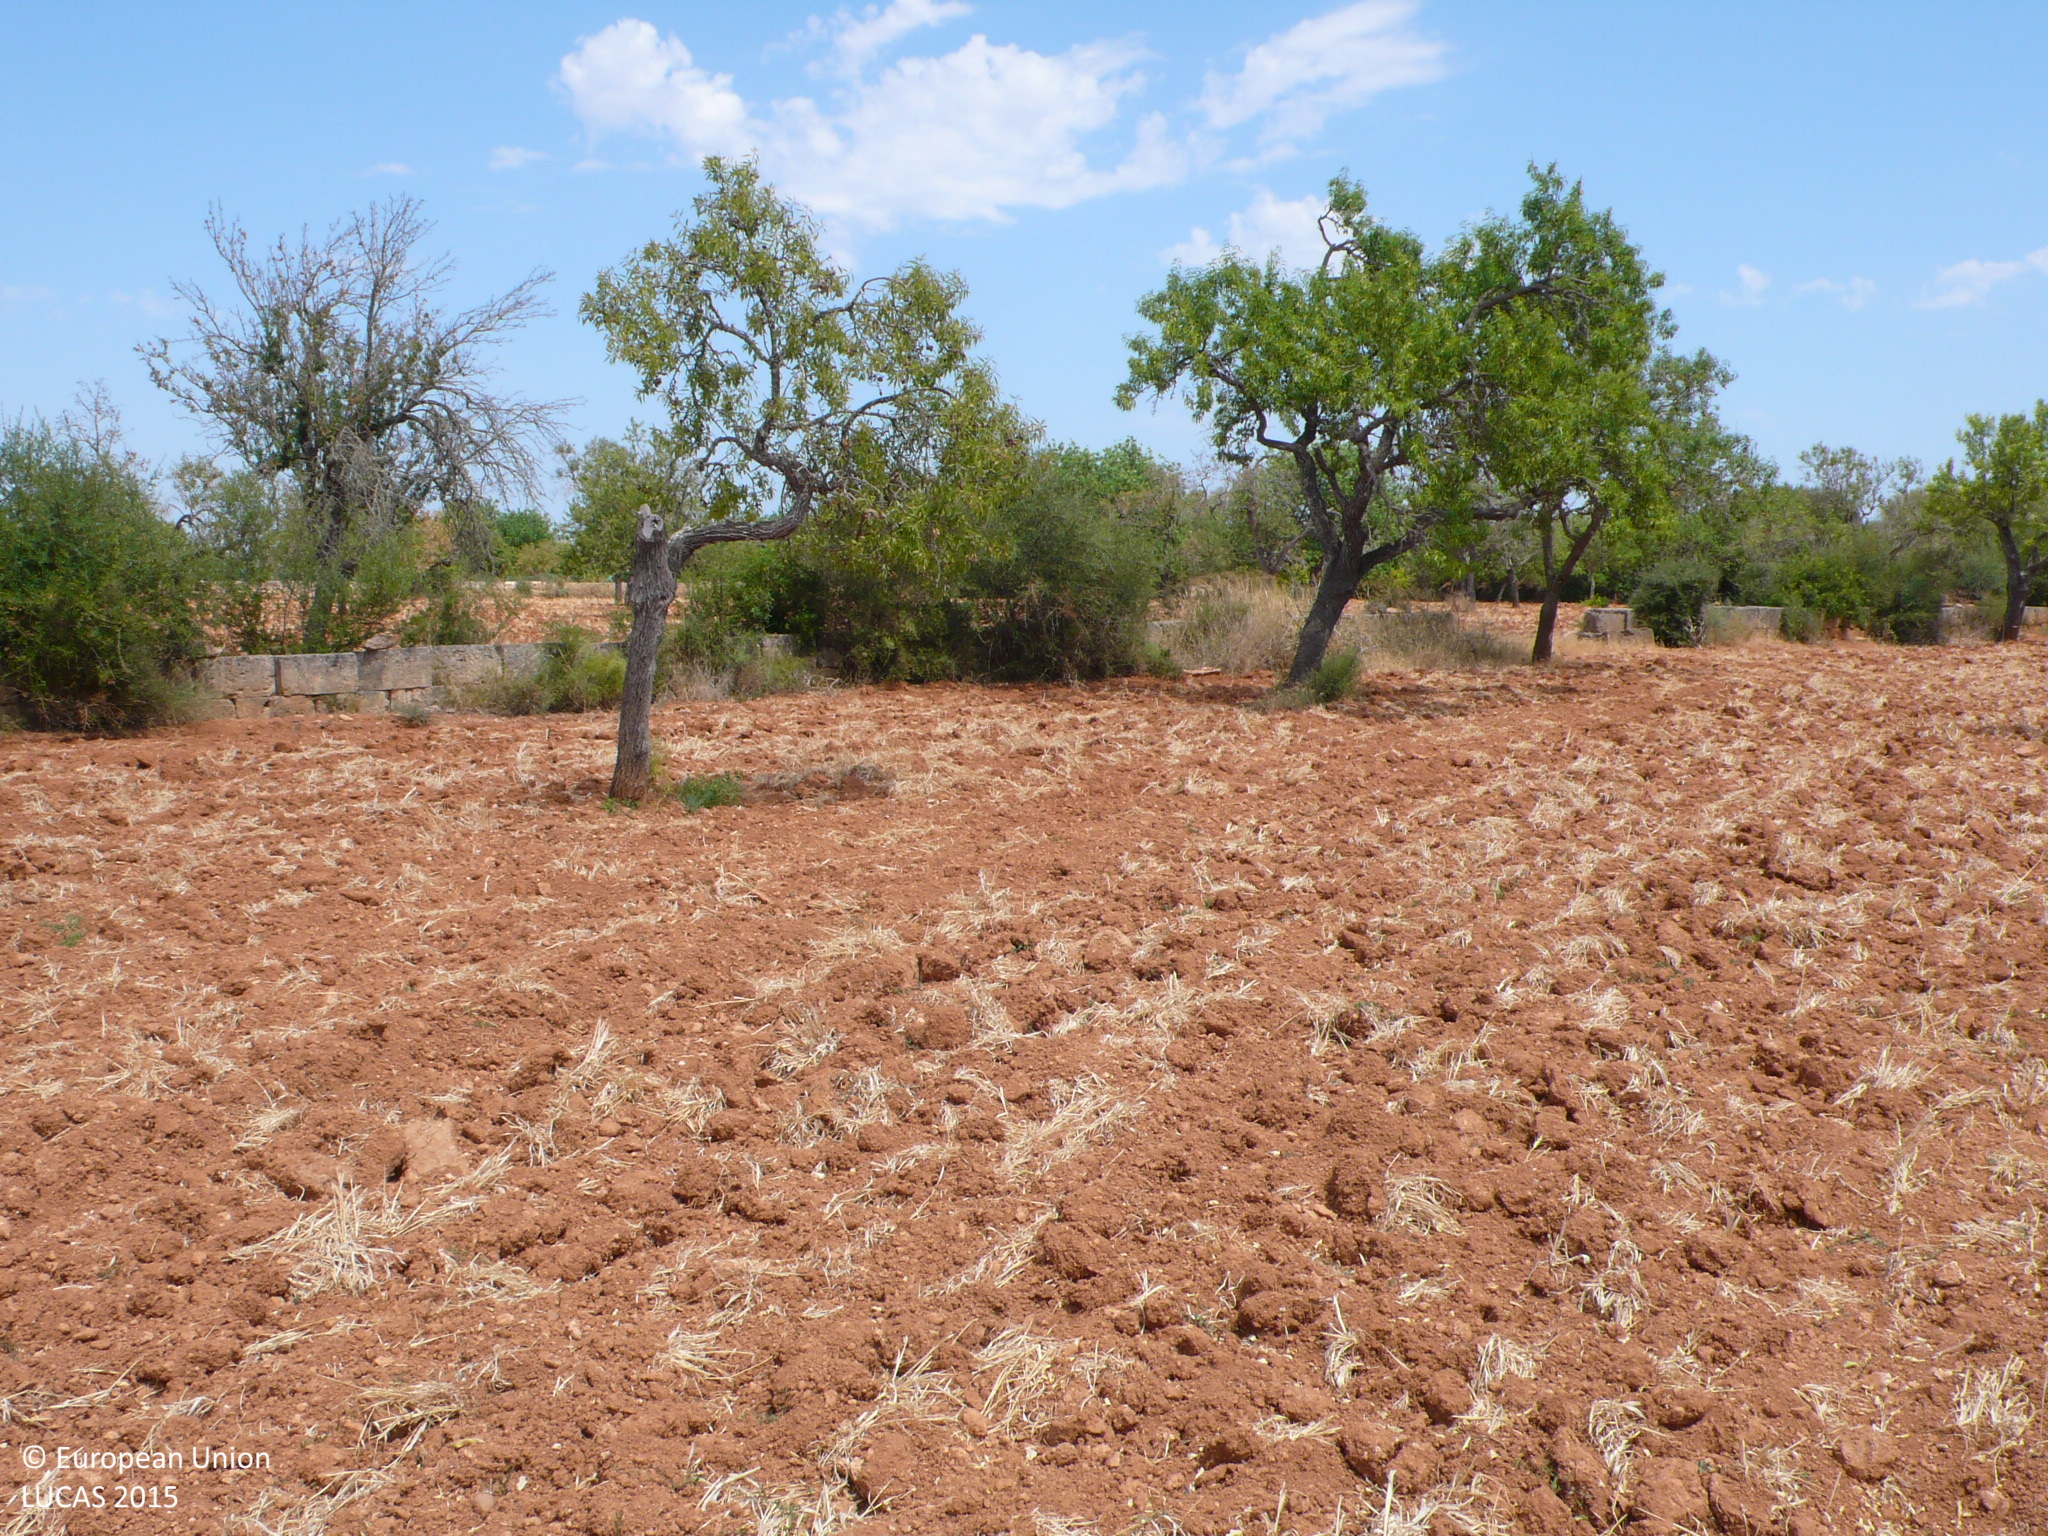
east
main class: Cropland
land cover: Nuts trees
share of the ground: 10 - 25 %
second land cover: Other bare soil
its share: > 75 %
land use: Agriculture (excluding fallow land and kitchen gardens)
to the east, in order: Nuts trees; Other bare soil; Artificial constructions; Abandoned hedges; Tracks; Other bare soil; Nuts trees; Permanent industrial crops; Artificial constructions; Nuts trees; Dry stone walls; Nuts trees; Dry stone walls; Nuts trees
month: July
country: ES
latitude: 39.4472
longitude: 2.9080
